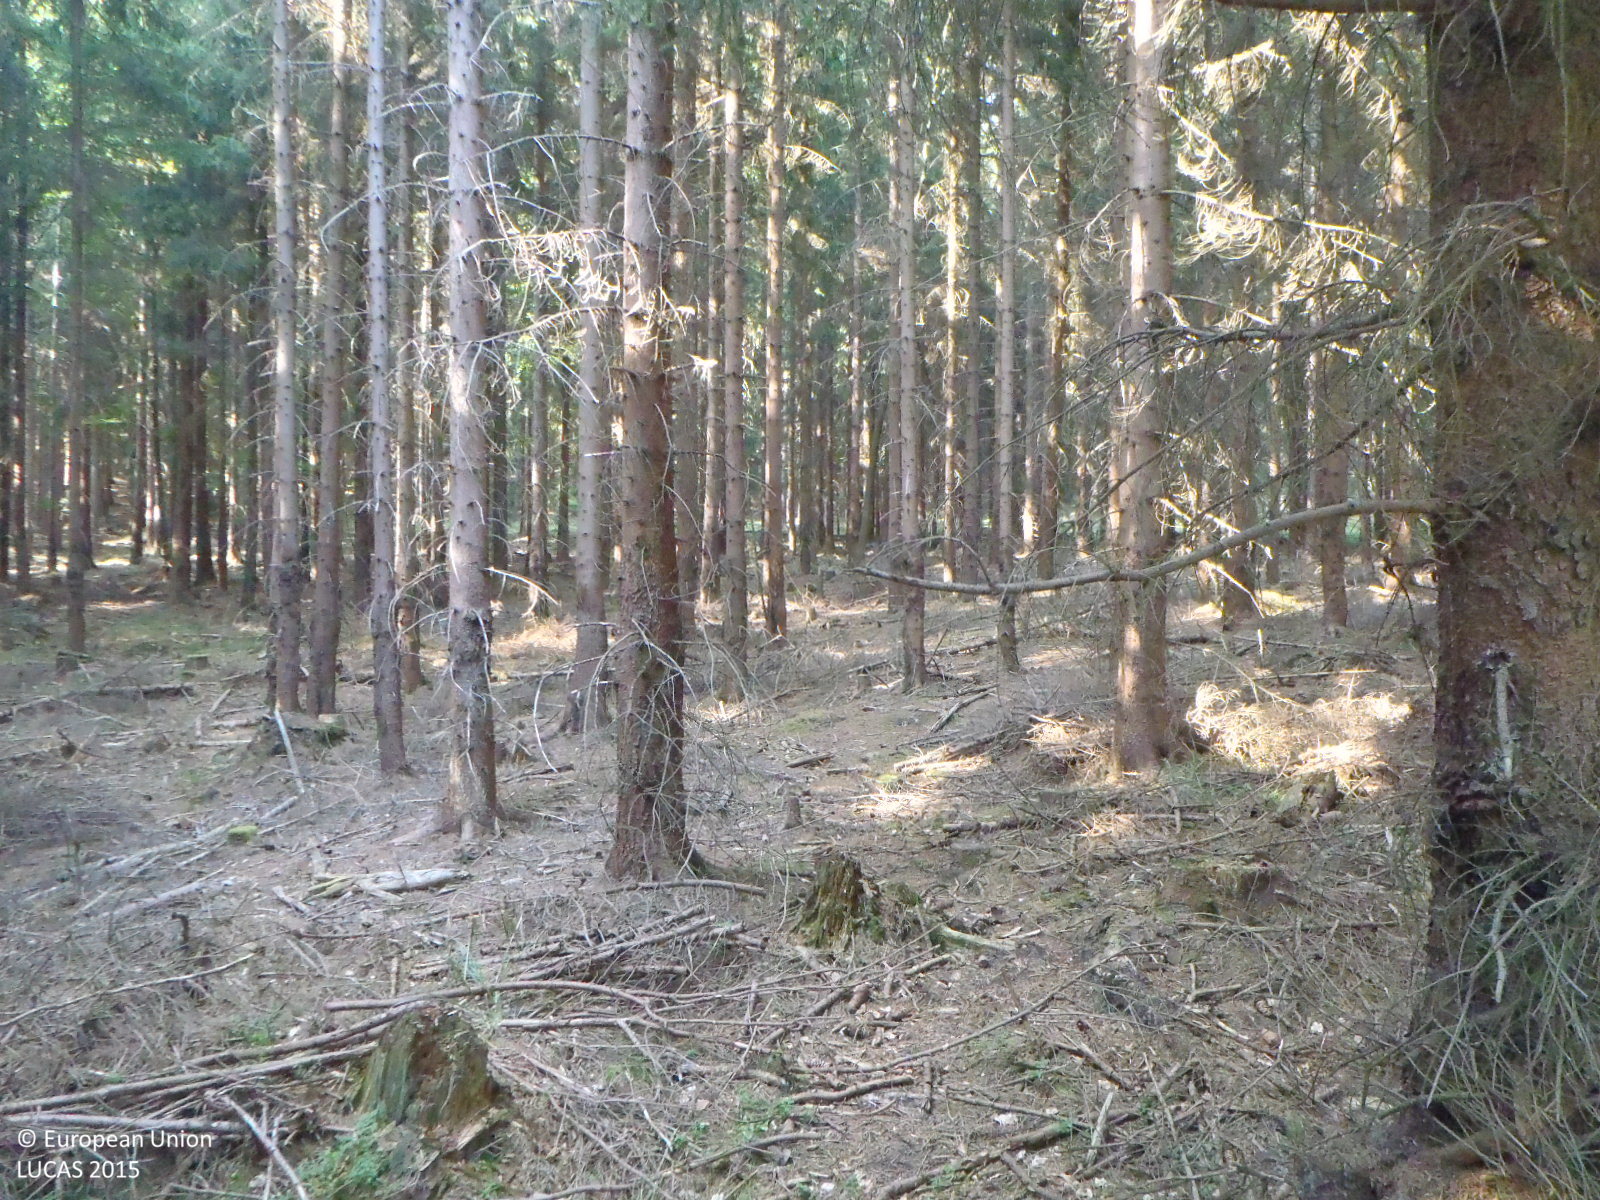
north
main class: Woodland
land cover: Other coniferous woodland
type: hemiboreal forest and nemoral coniferous forest and mixed broadleaved-coniferous forest
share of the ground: > 75 %
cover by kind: coniferous forest trees 100 %
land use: Forestry
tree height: > 5 m
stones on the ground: < 10 %
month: August
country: CZ
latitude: 50.8158
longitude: 14.5012
